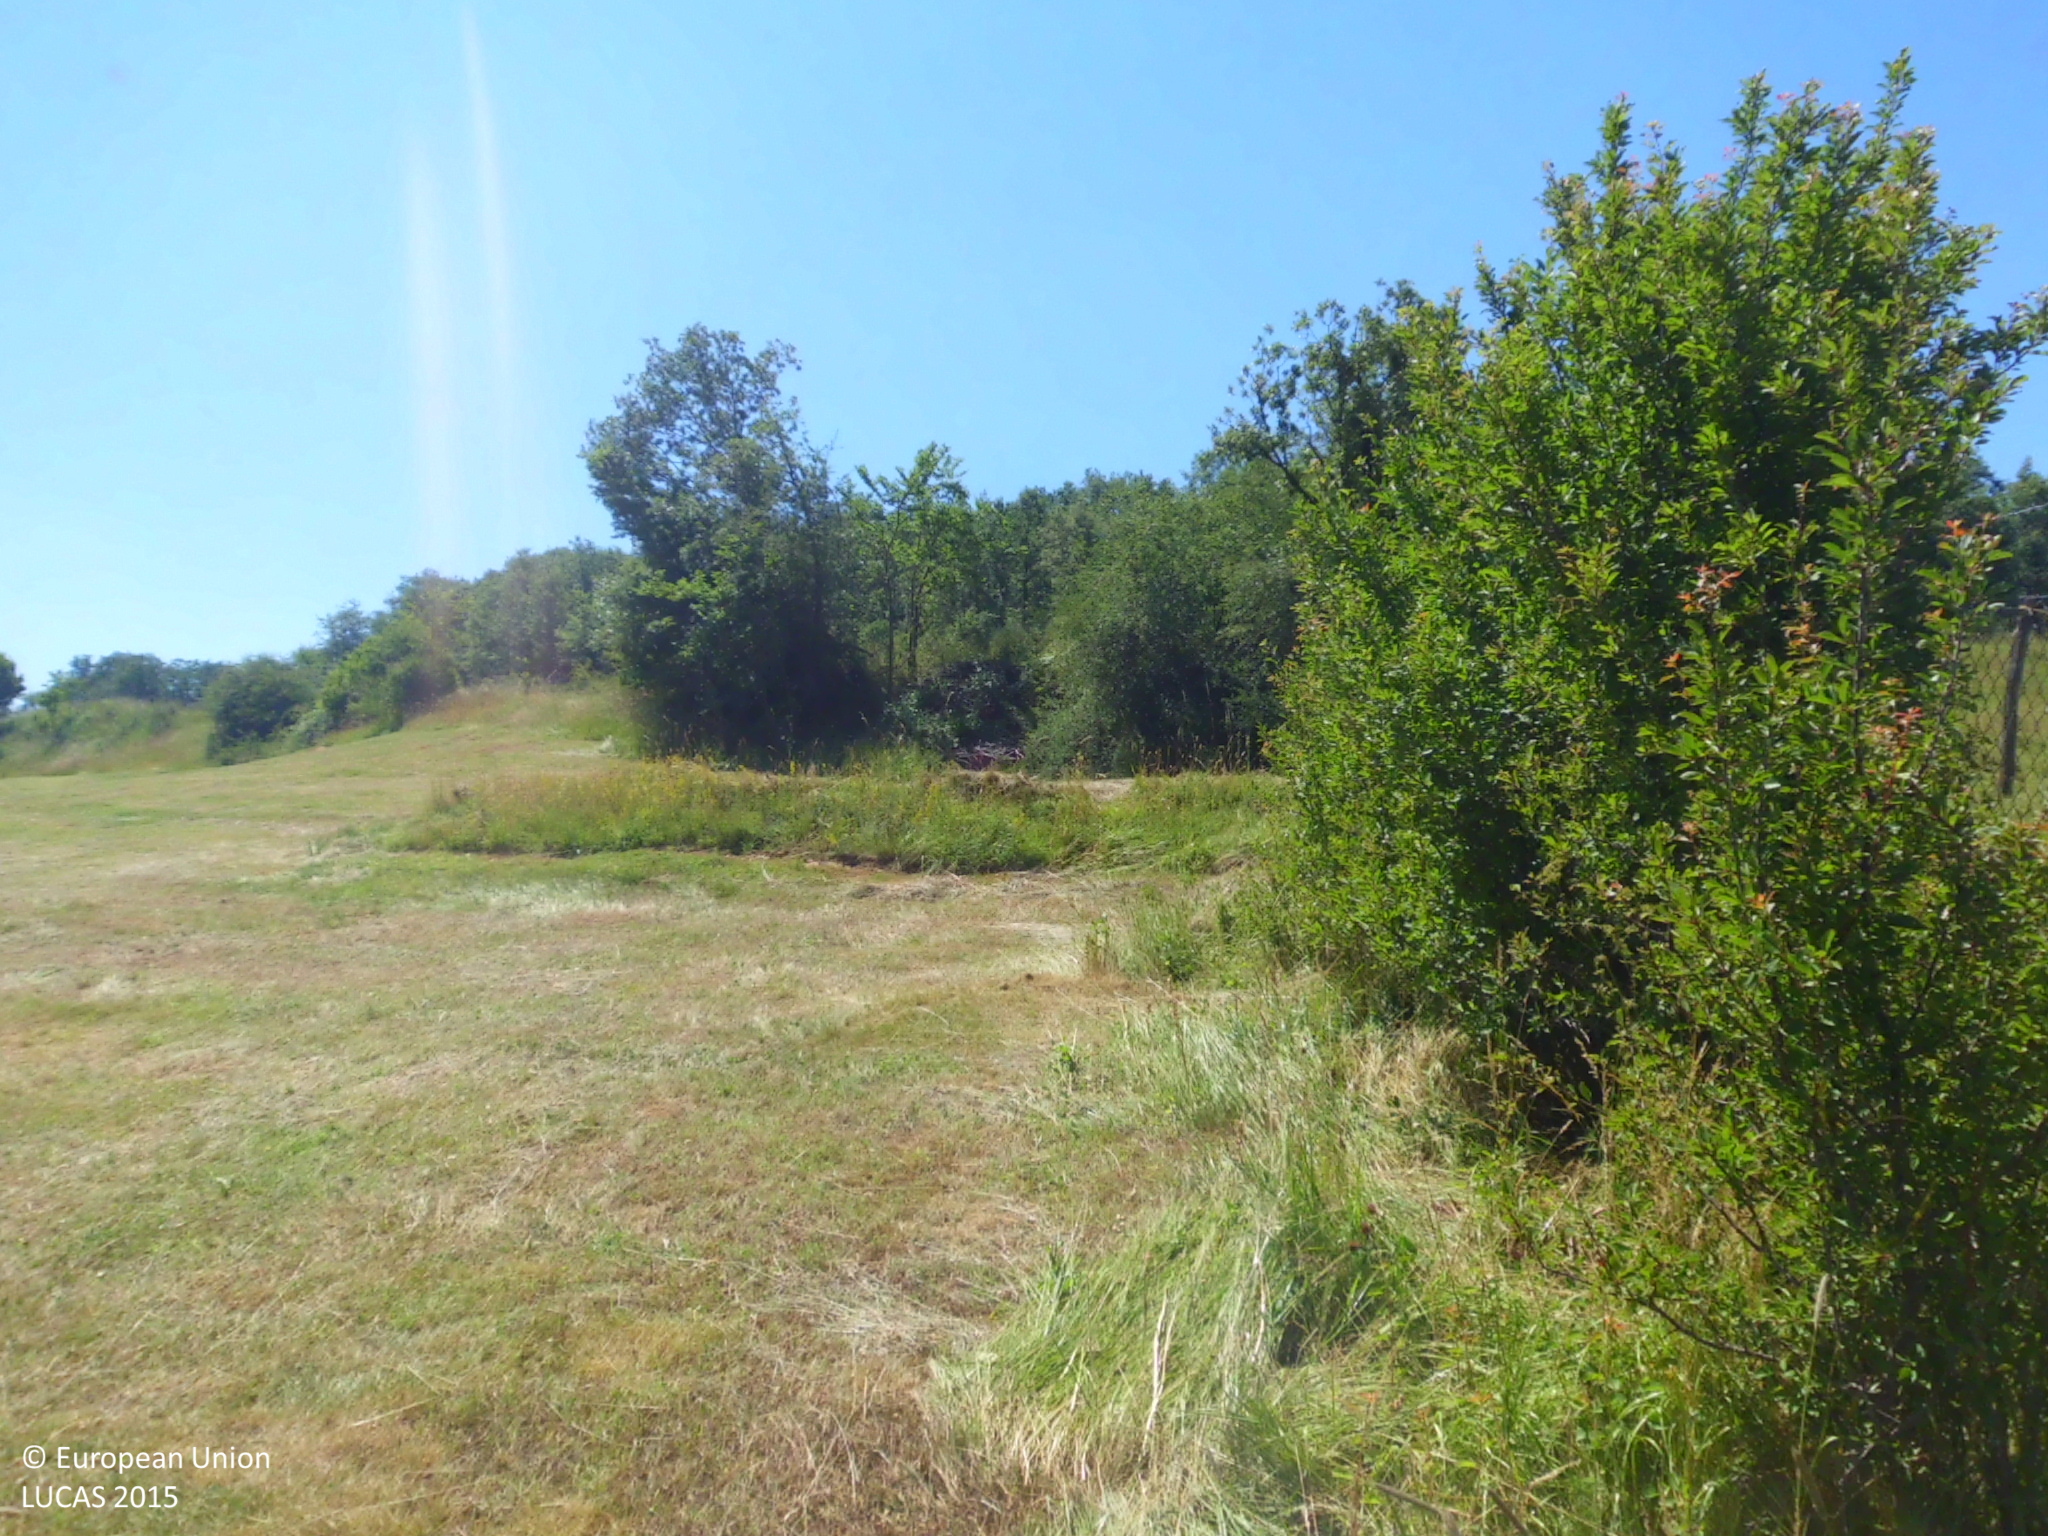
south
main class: Grassland
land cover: Grassland with sparse tree/shrub cover
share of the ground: > 75 %
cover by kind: herbaceous plants 80 %, unconsolidated bare surface 15 %, broadleaved forest trees 5 %
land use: Agriculture (excluding fallow land and kitchen gardens)
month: June
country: ES
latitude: 42.7855
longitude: -4.9393
